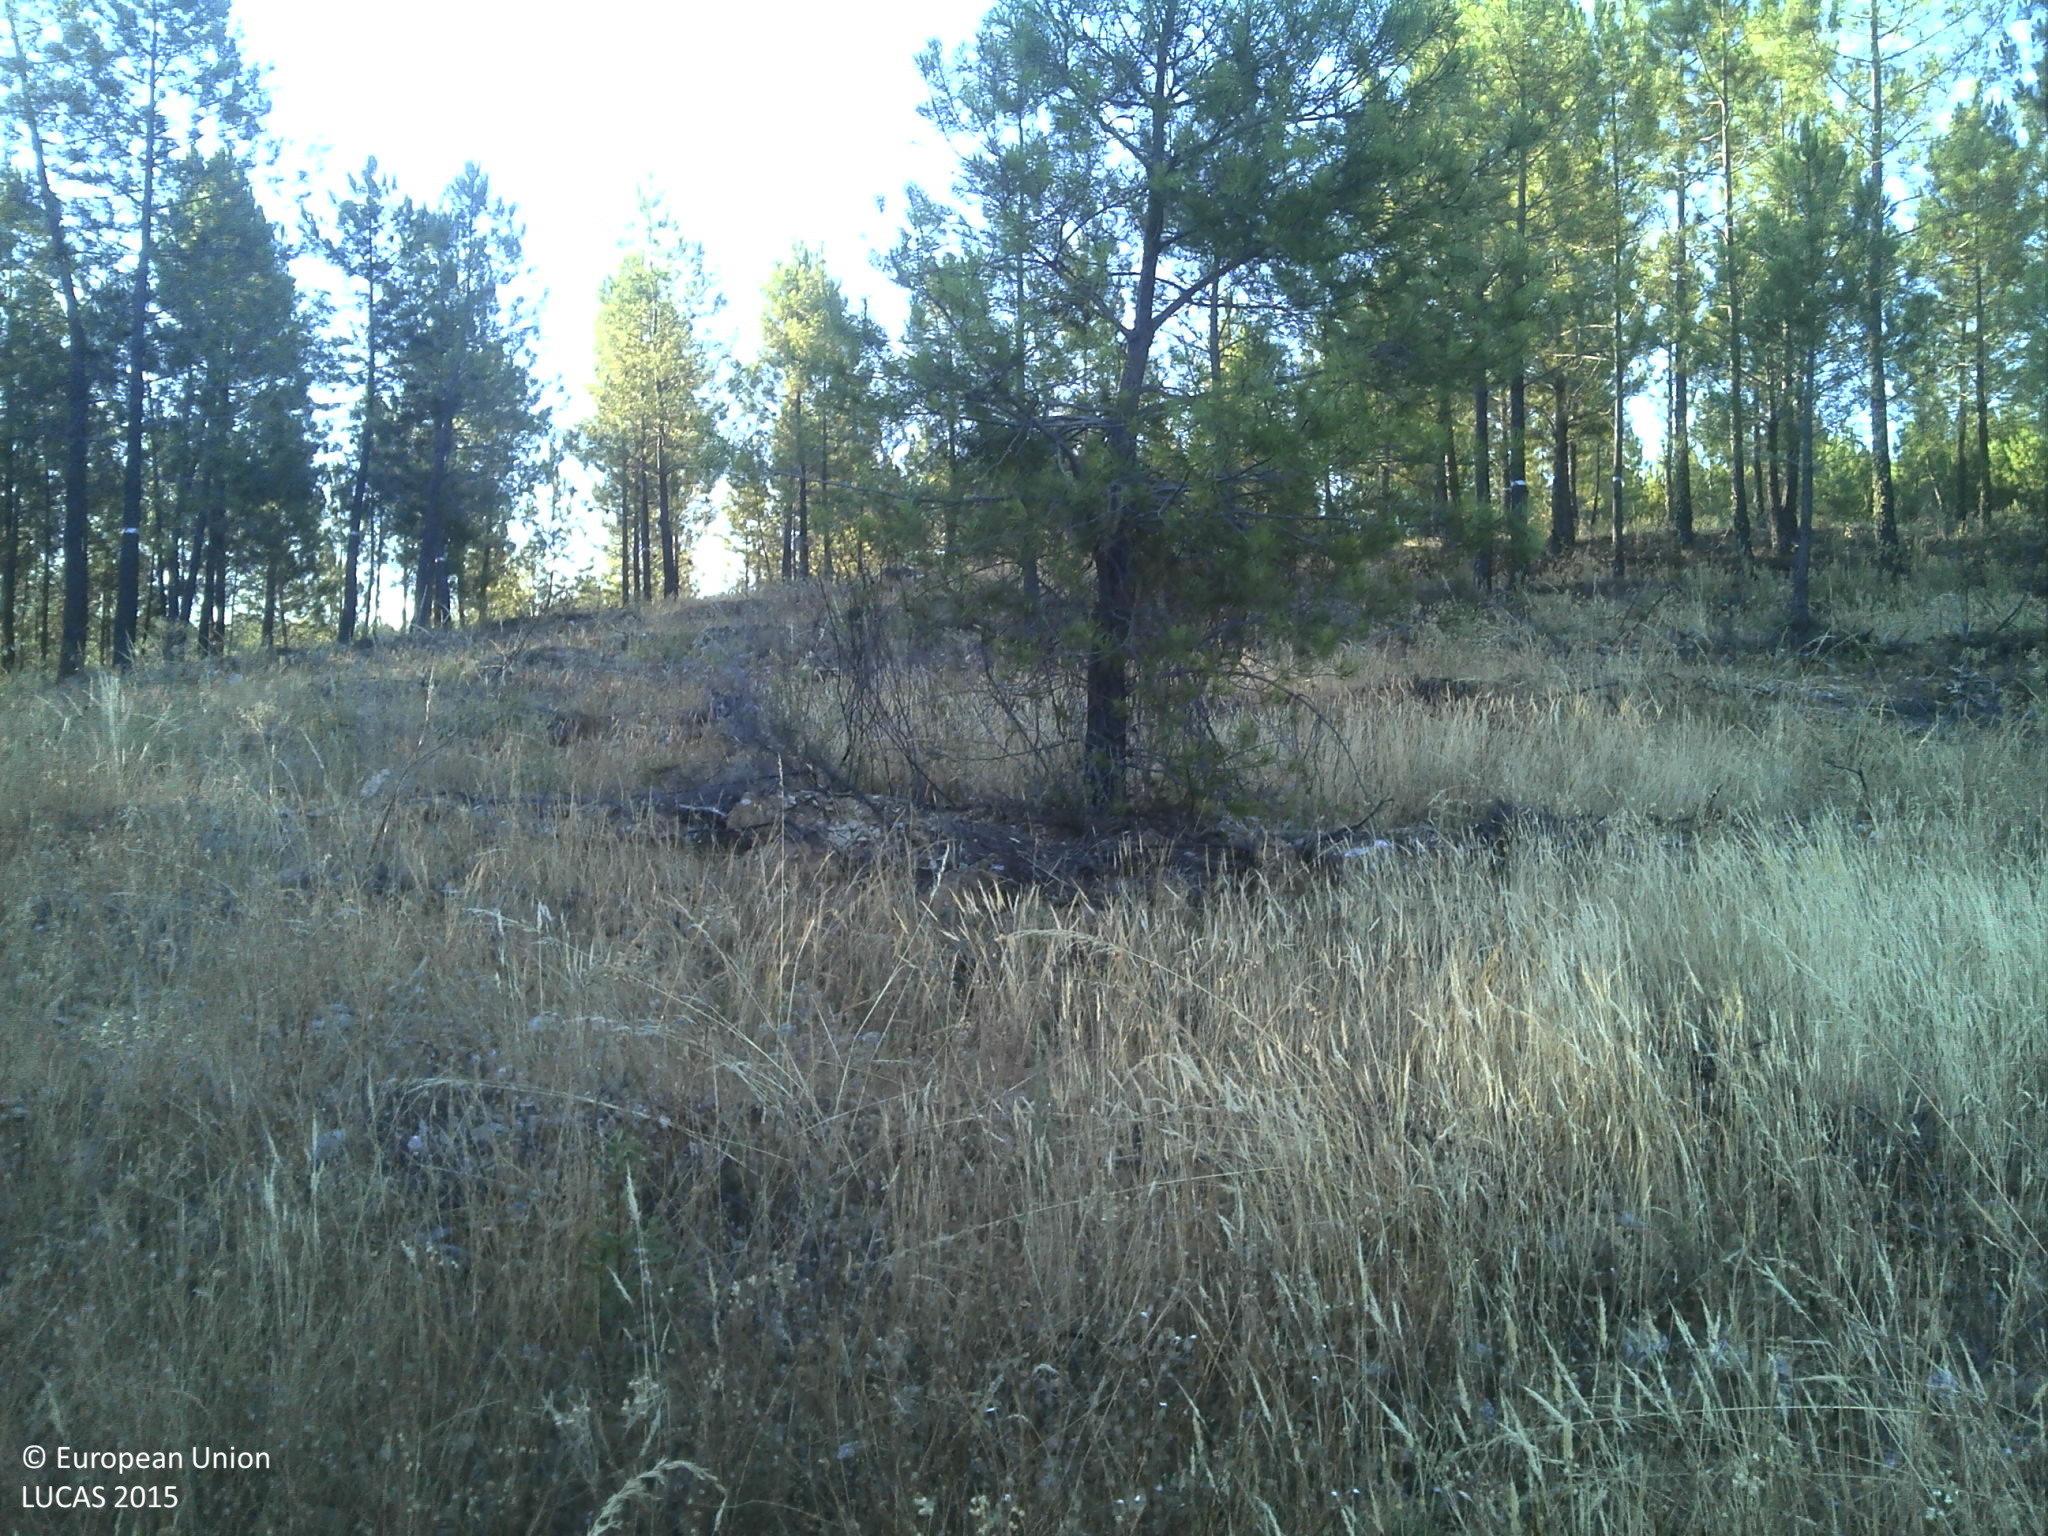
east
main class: Woodland
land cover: Pine dominated coniferous woodland
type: coniferous forest of the mediterranean region
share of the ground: 10 - 25 %
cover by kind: unconsolidated bare surface 30 %, coniferous forest trees 25 %, herbaceous plants 25 %, shrubs 20 %
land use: Forestry
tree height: > 5 m
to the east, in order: Pine dominated coniferous woodland; Tracks; Pine dominated coniferous woodland; Broadleaved woodland; Grassland without tree/shrub cover; Pine dominated coniferous woodland
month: July
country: PT
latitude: 39.9580
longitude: -7.5808
